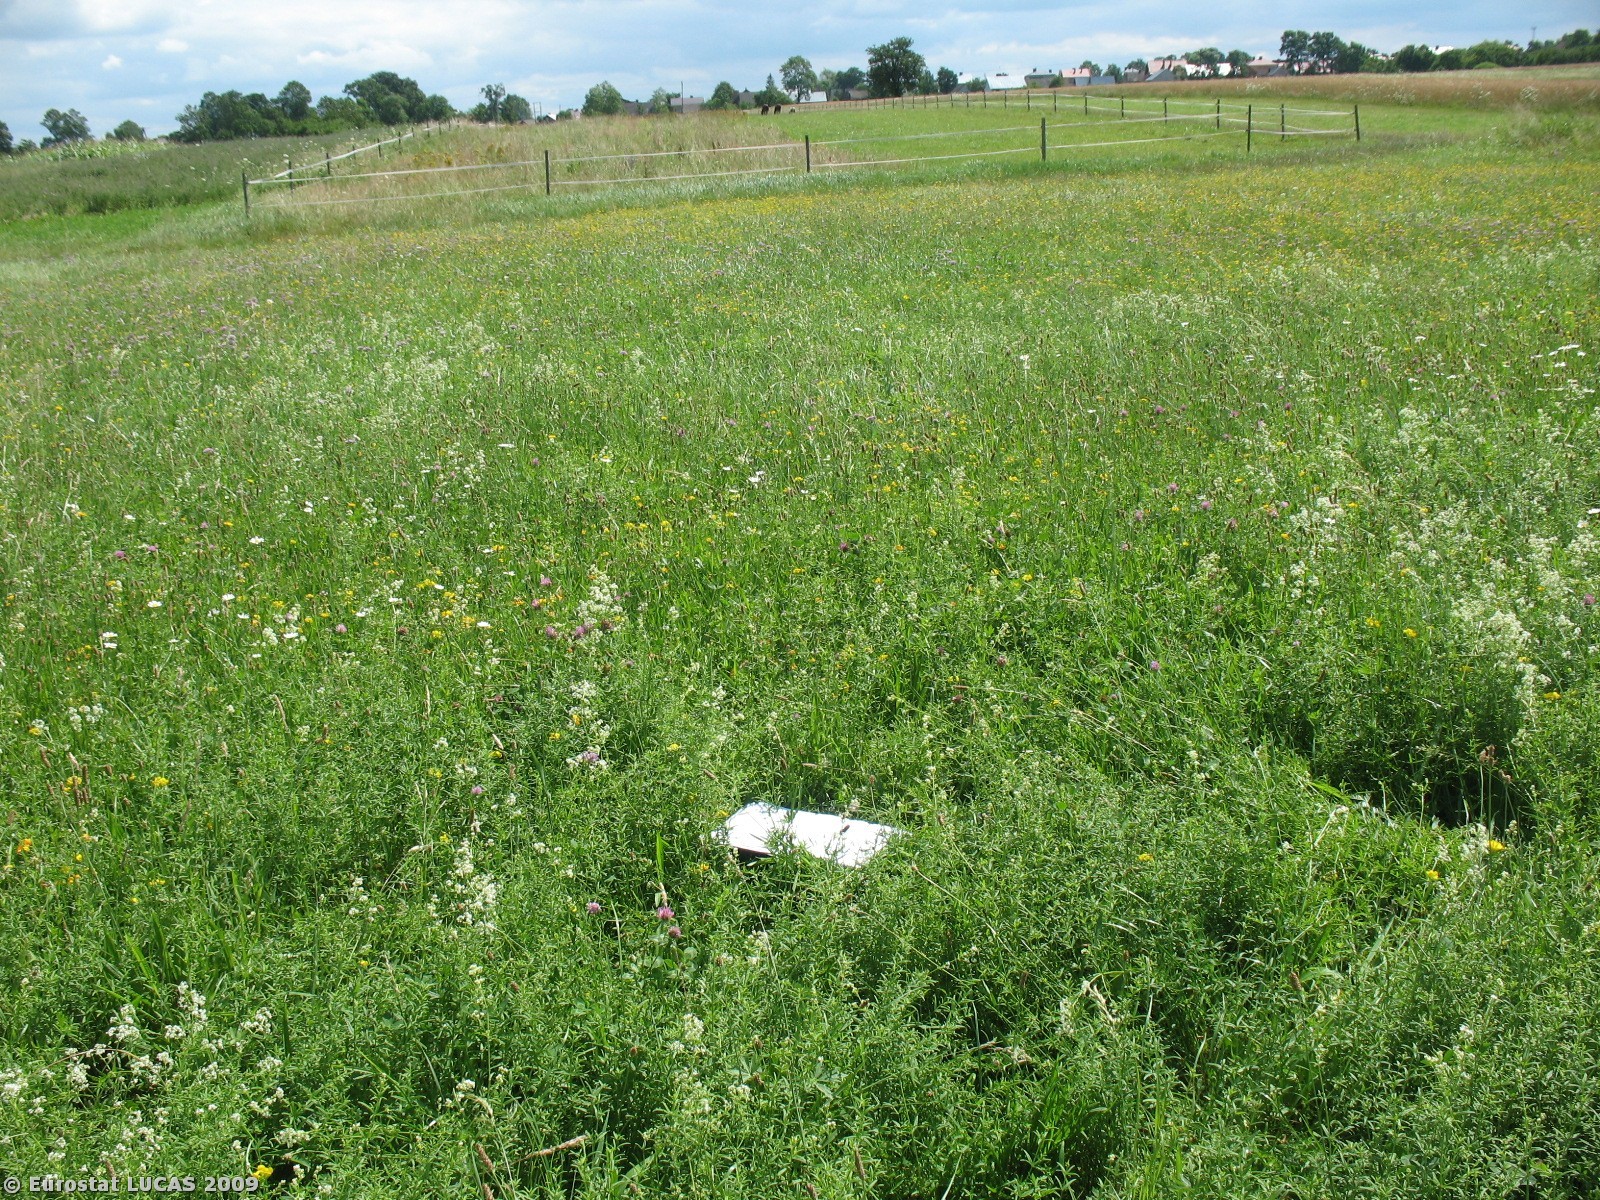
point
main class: Grassland
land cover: Grassland without tree/shrub cover
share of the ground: > 75 %
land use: Agriculture (excluding fallow land and kitchen gardens)
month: July
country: PL
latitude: 50.3165
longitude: 22.1233
